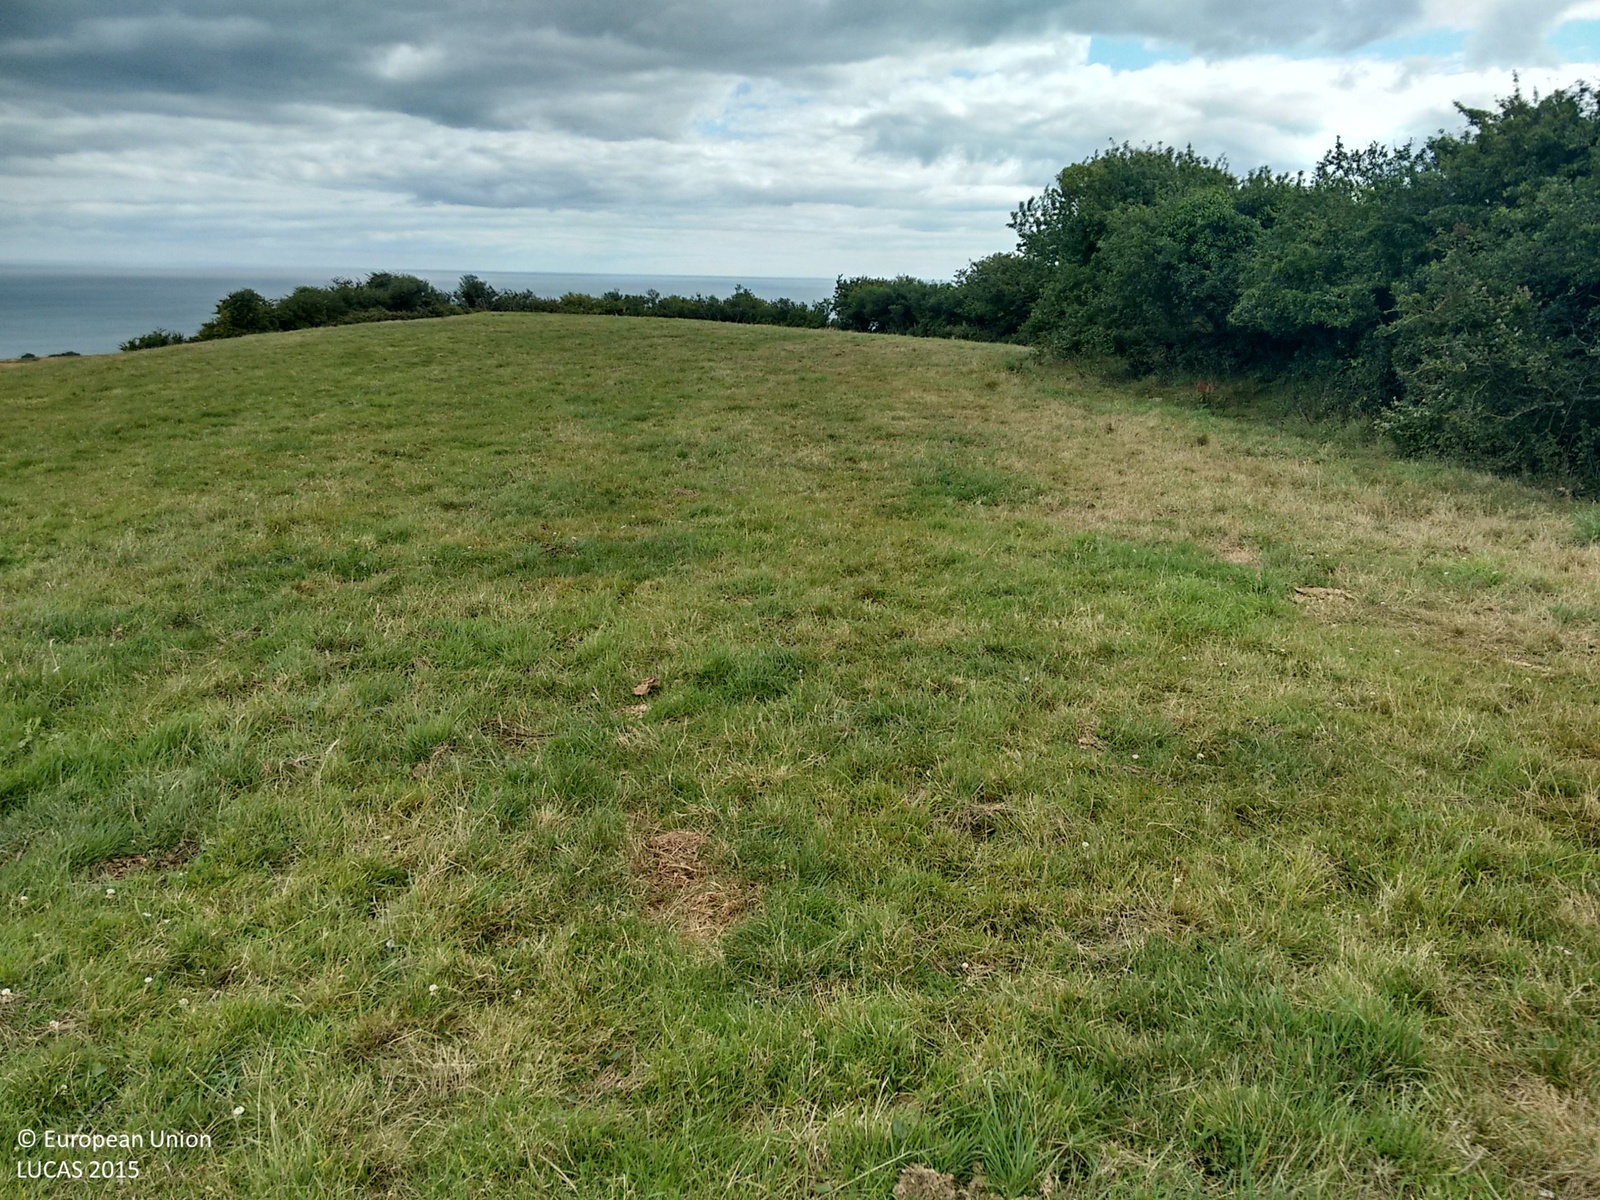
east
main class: Grassland
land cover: Grassland without tree/shrub cover
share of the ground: > 75 %
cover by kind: herbaceous plants 85 %, unconsolidated bare surface 15 %
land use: Agriculture (excluding fallow land and kitchen gardens)
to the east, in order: Grassland without tree/shrub cover; Fences; Shrubland without tree cover; Spontaneously vegetated surfaces; Tracks; Spontaneously vegetated surfaces; Broadleaved woodland
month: July
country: GB
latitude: 50.3781
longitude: -3.5130
